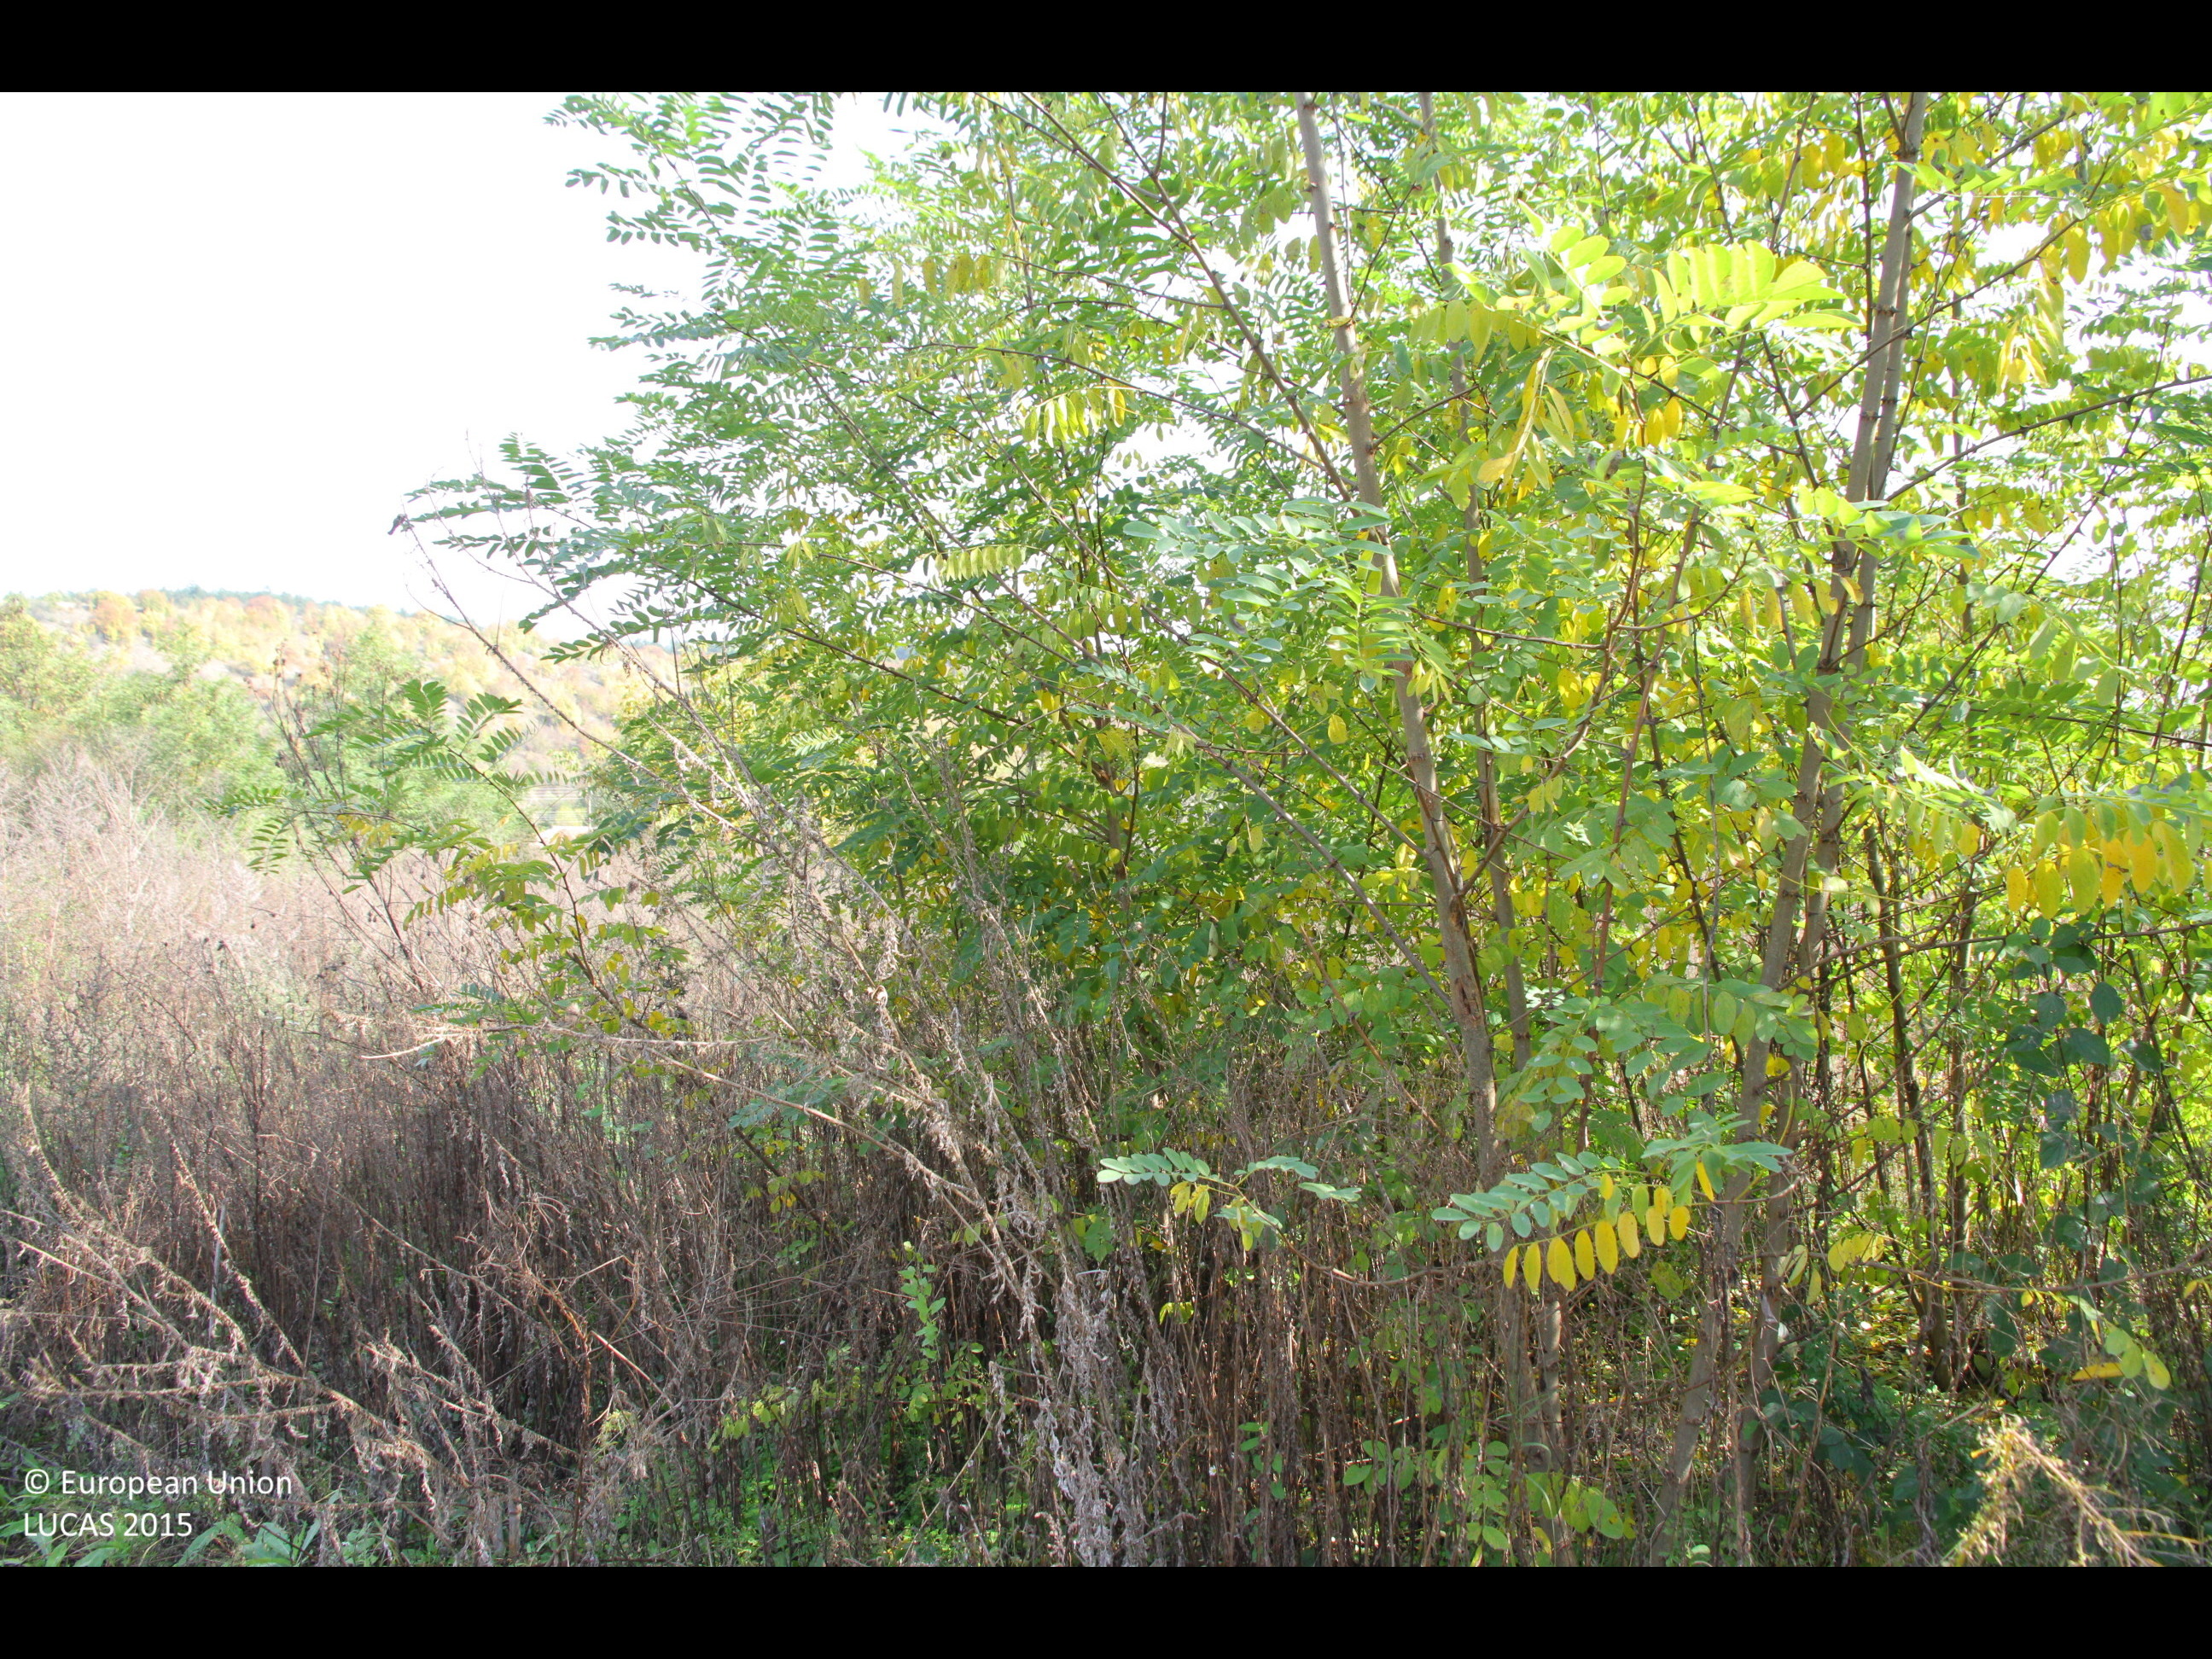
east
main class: Grassland
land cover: Spontaneously vegetated surfaces
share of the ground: > 75 %
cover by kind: herbaceous plants 95 %, shrubs 5 %
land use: Agriculture (excluding fallow land and kitchen gardens)
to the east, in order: Spontaneously vegetated surfaces; Abandoned hedges; Electric lines; Grassland without tree/shrub cover; Abandoned hedges; Grassland without tree/shrub cover; Abandoned hedges; Artificial constructions in urban areas; Rivers and streams; Artificial constructions in urban areas
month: October
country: BG
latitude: 43.6445
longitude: 26.3807
